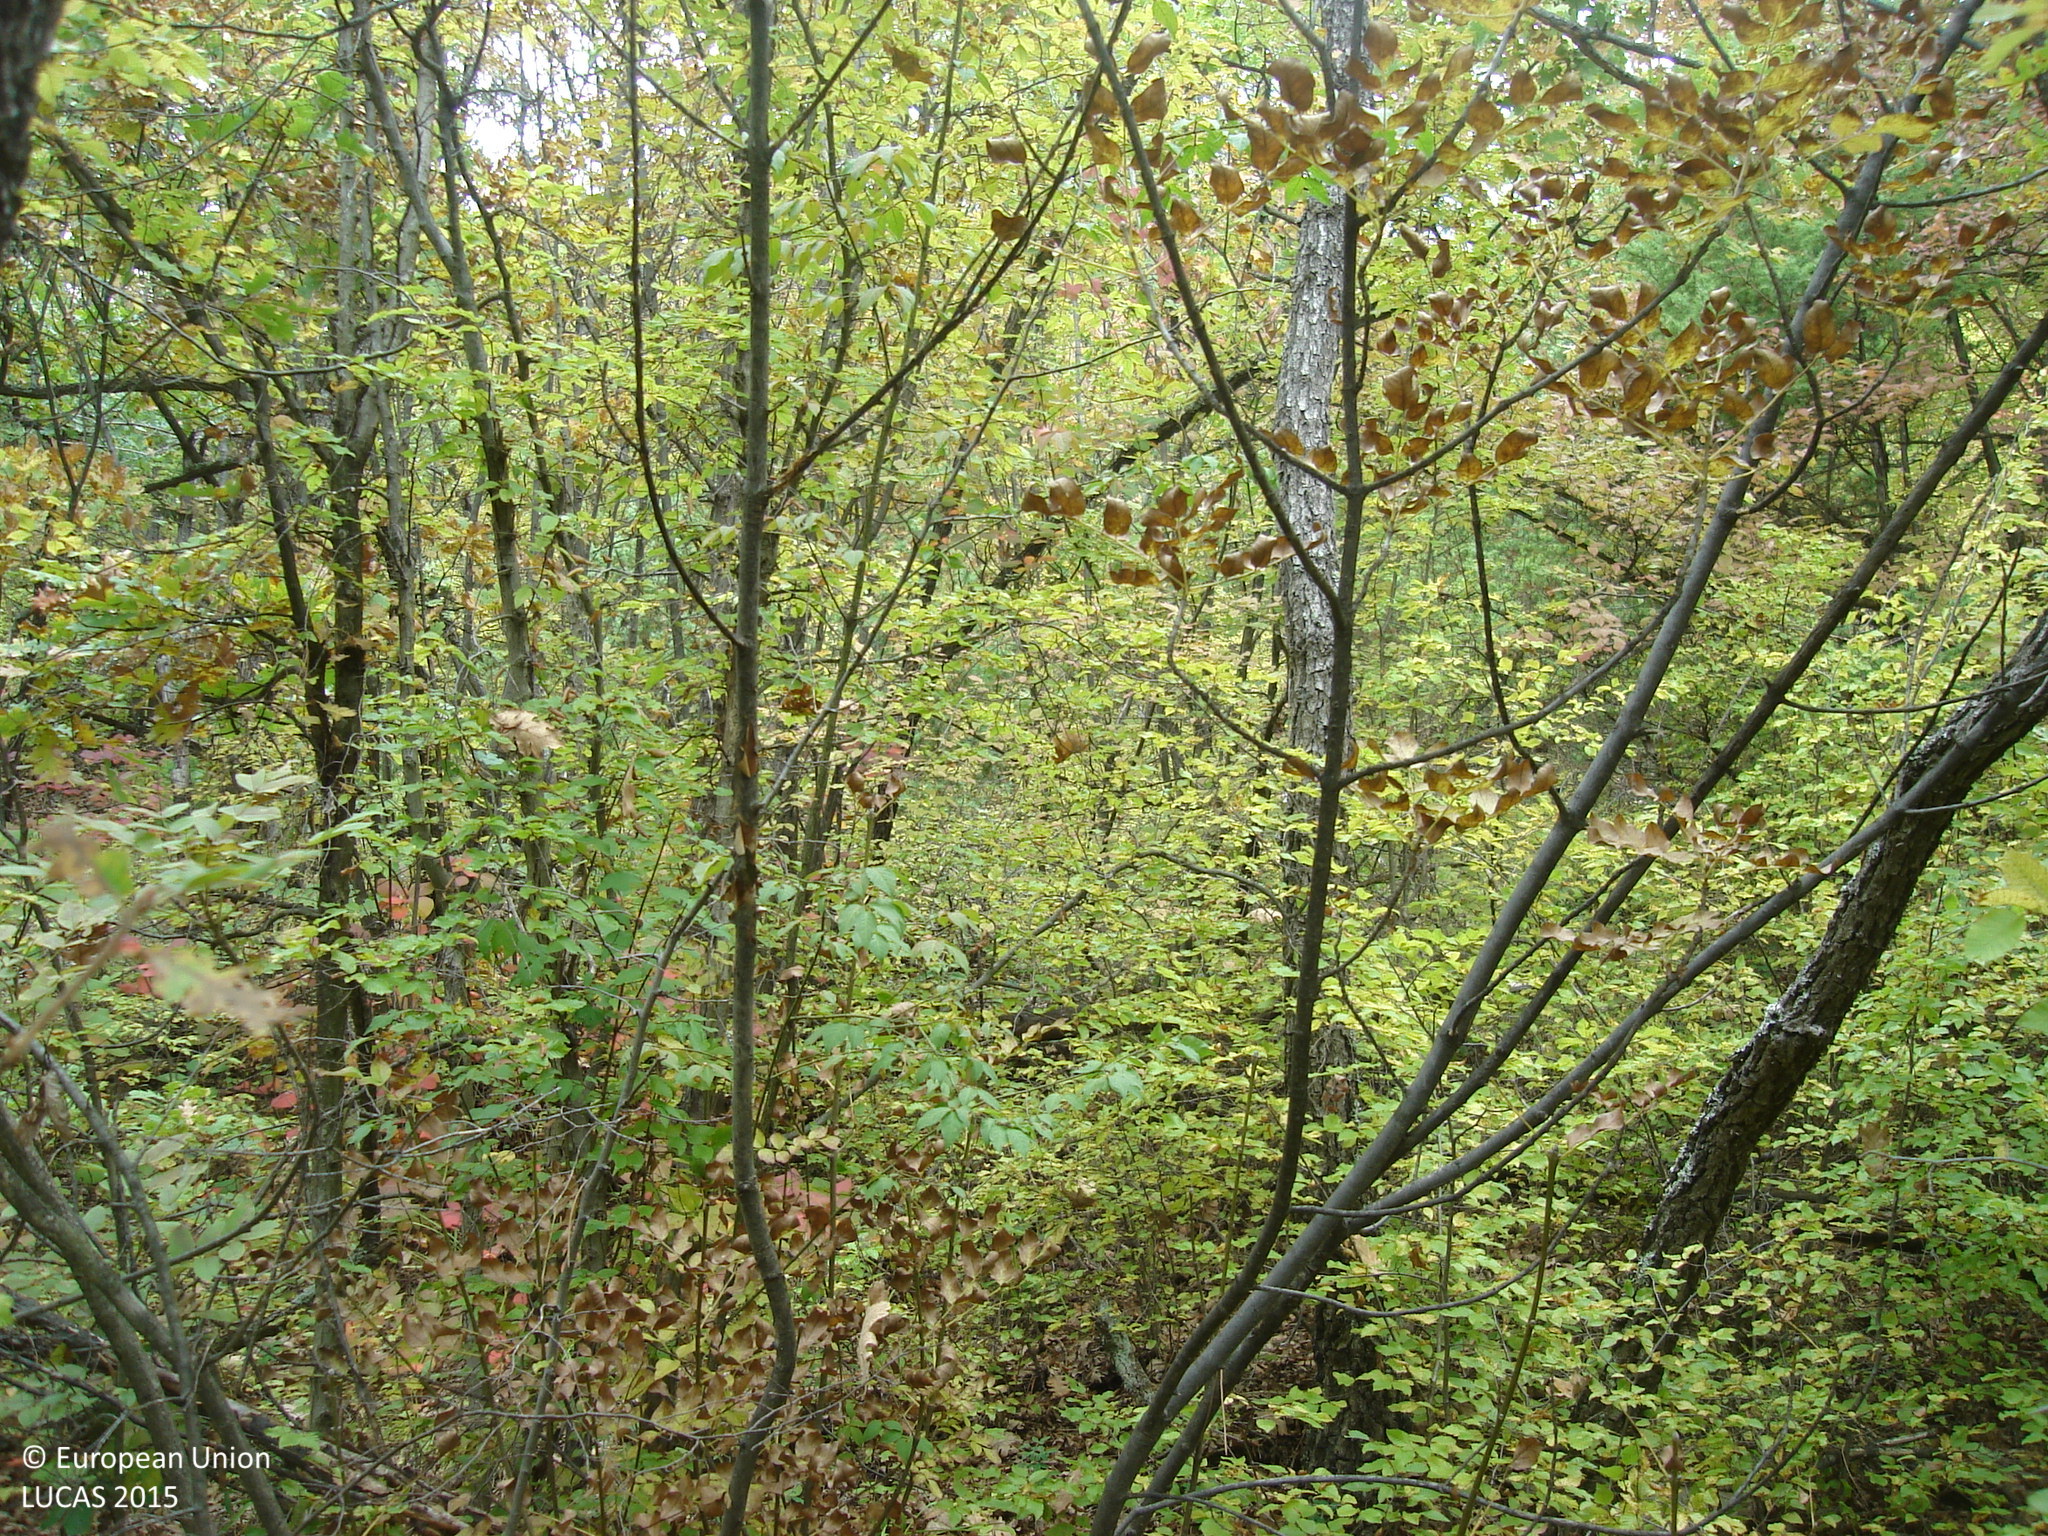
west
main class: Woodland
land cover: Broadleaved woodland
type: mesophytic deciduous forest
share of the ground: > 75 %
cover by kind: broadleaved forest trees 80 %, shrubs 10 %, herbaceous plants 5 %, unconsolidated bare surface 5 %
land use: Forestry
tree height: > 5 m
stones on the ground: < 10 %
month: October
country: BG
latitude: 42.6127
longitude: 23.9771
